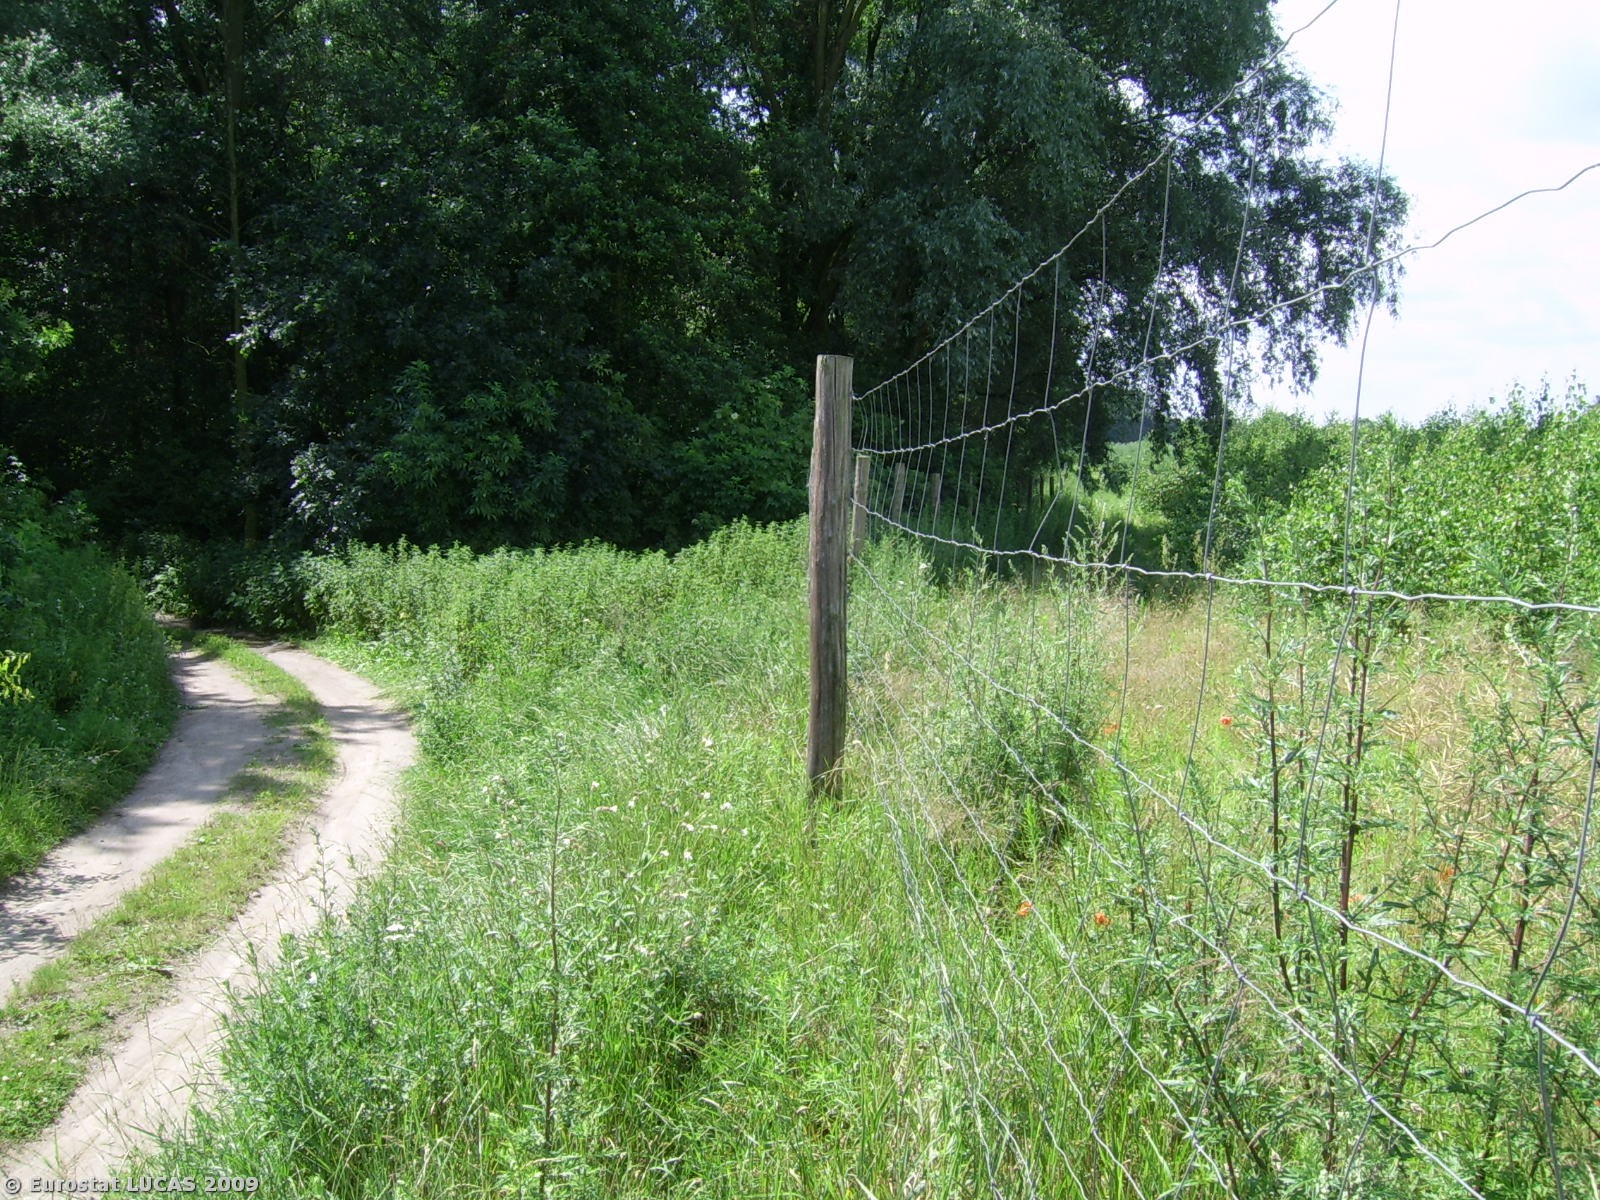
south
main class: Woodland
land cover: Broadleaved woodland
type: mesophytic deciduous forest
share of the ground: > 75 %
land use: Nature reserves
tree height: > 5 m
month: July
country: PL
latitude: 52.6048
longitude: 18.1228
